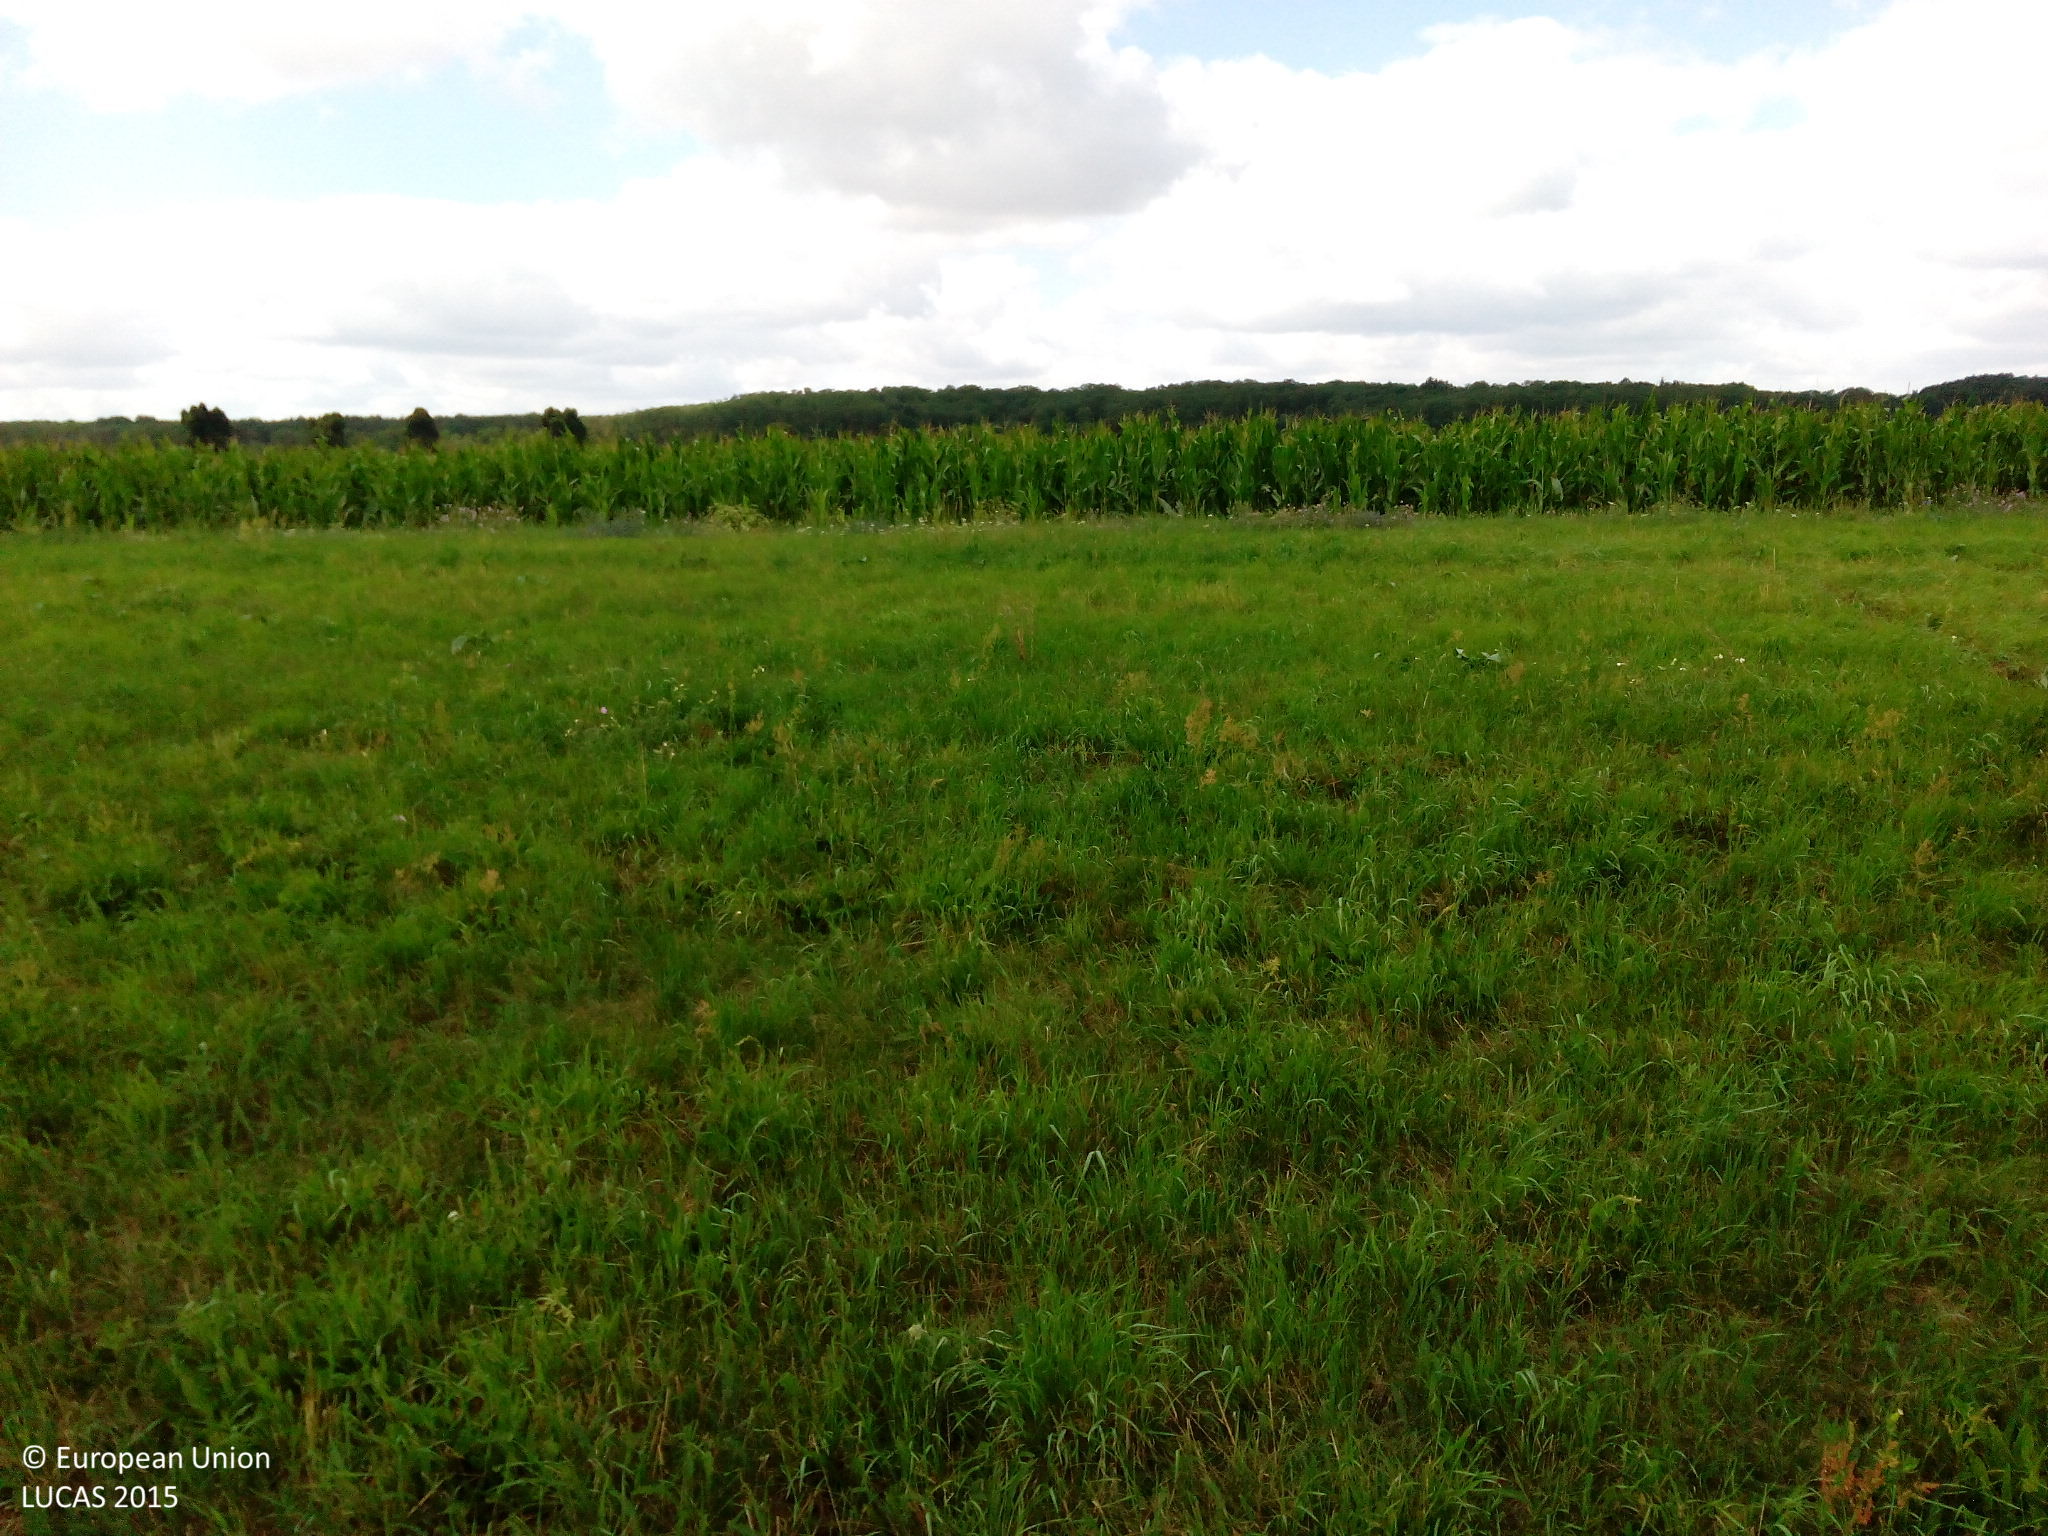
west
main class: Grassland
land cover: Grassland without tree/shrub cover
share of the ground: > 75 %
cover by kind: herbaceous plants 100 %
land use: Agriculture (excluding fallow land and kitchen gardens)
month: July
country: DE
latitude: 52.6827
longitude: 14.1576
